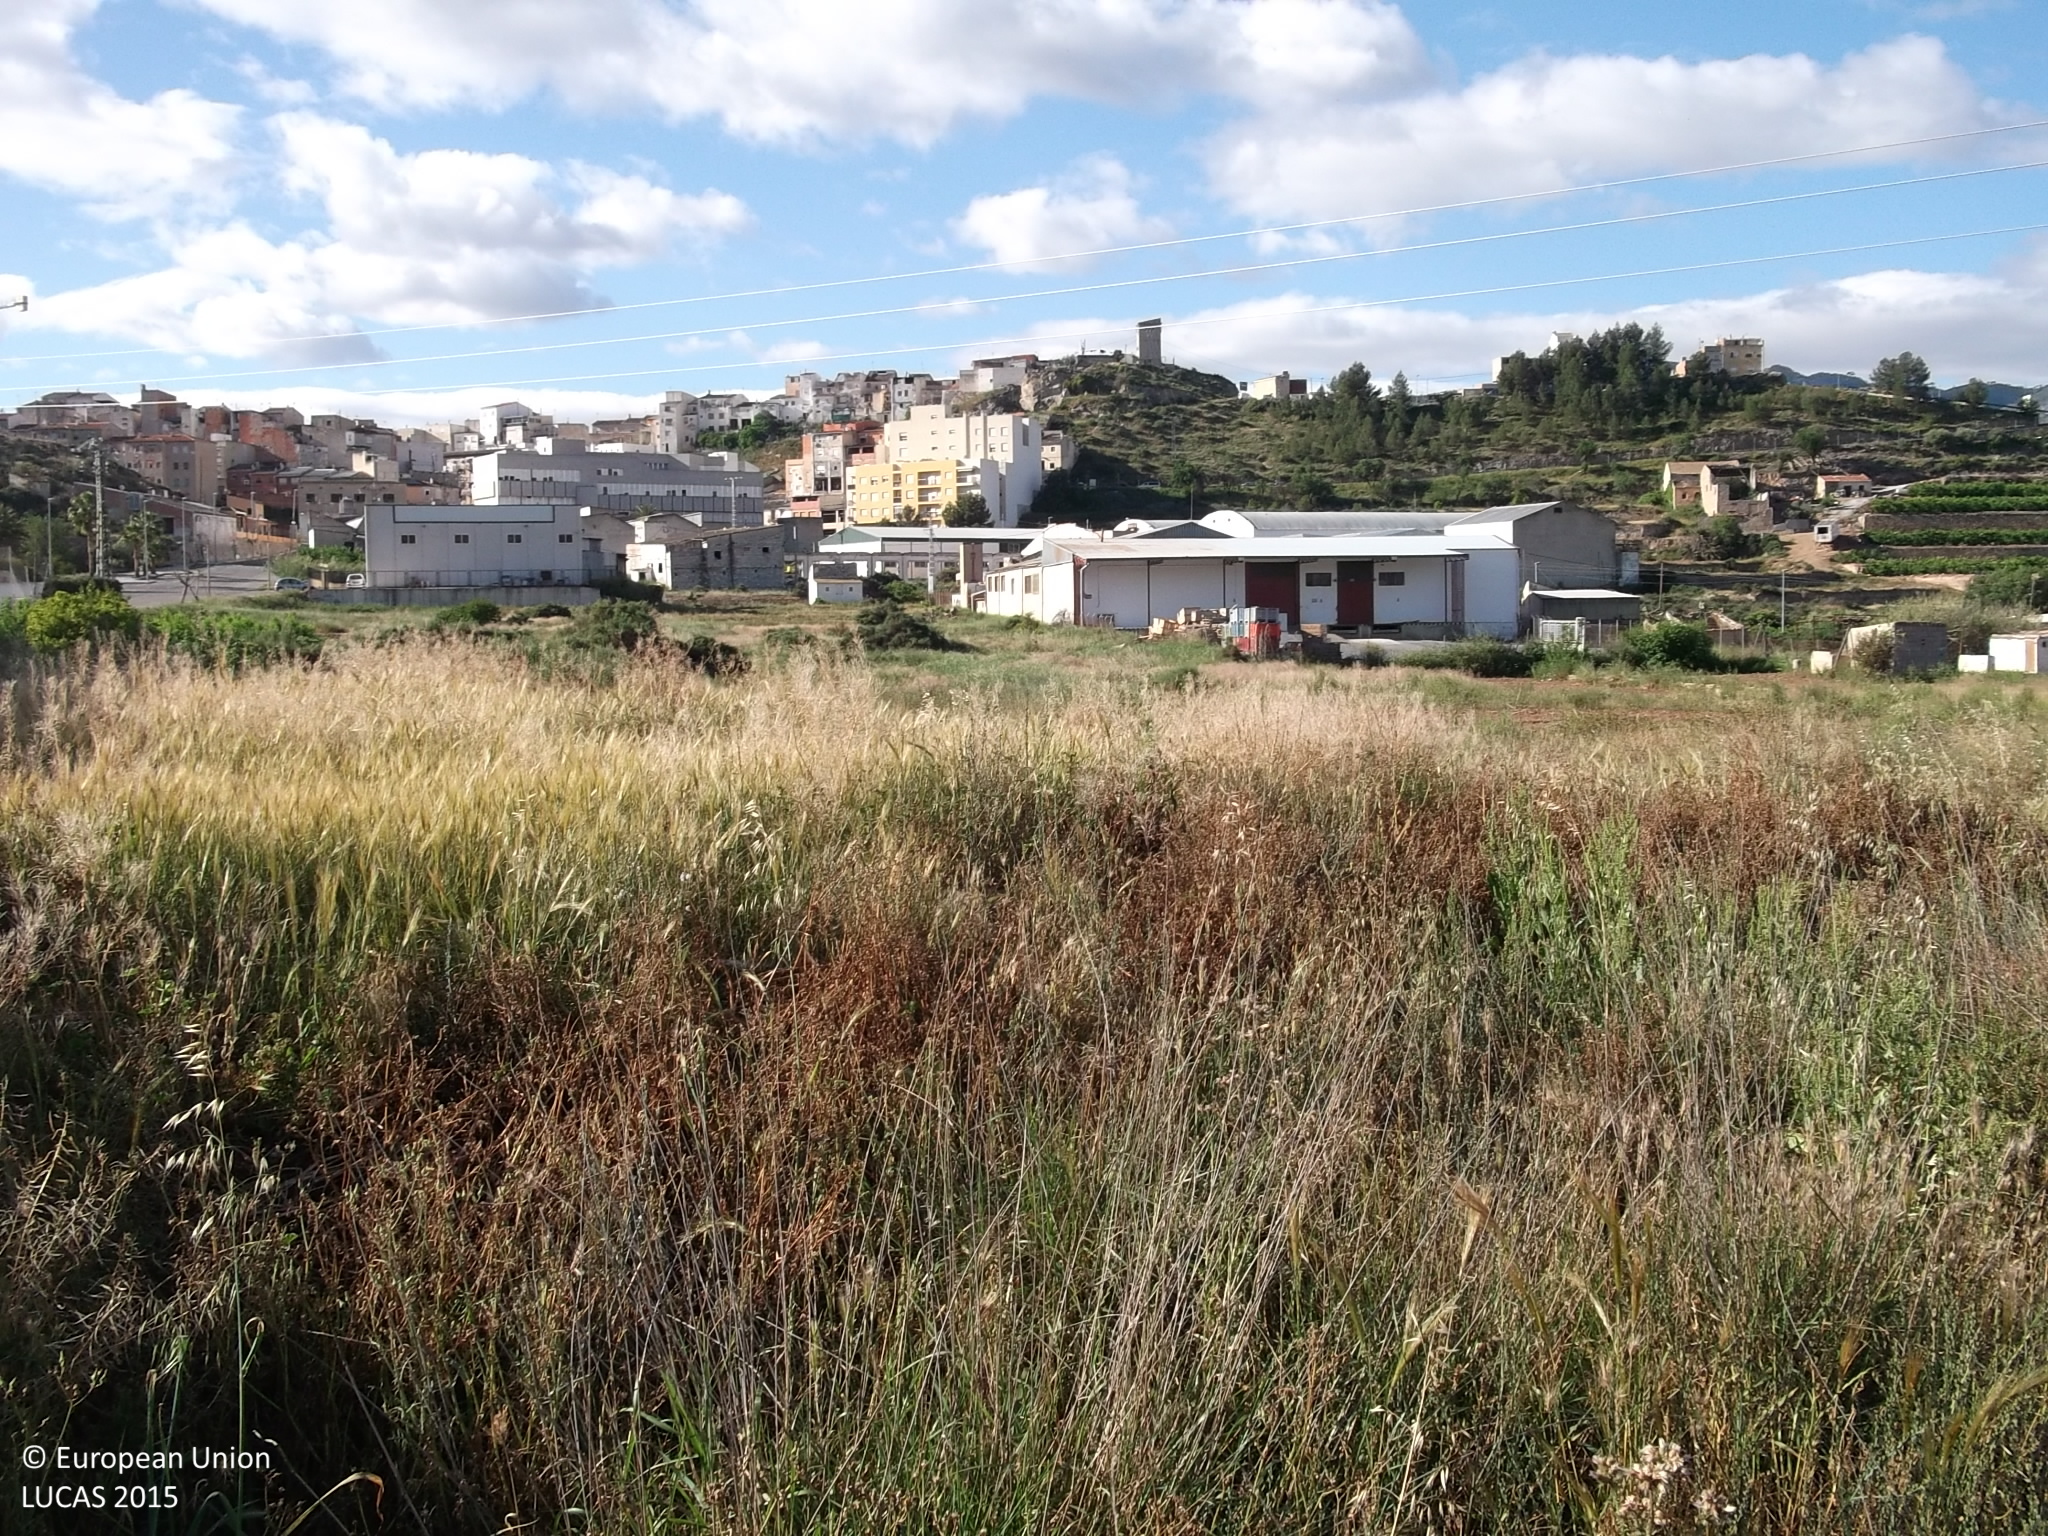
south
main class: Grassland
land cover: Spontaneously vegetated surfaces
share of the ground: > 75 %
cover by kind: herbaceous plants 90 %, consolidated bare surface 10 %
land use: Abandoned areas
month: April
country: ES
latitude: 38.2123
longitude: -1.3975
